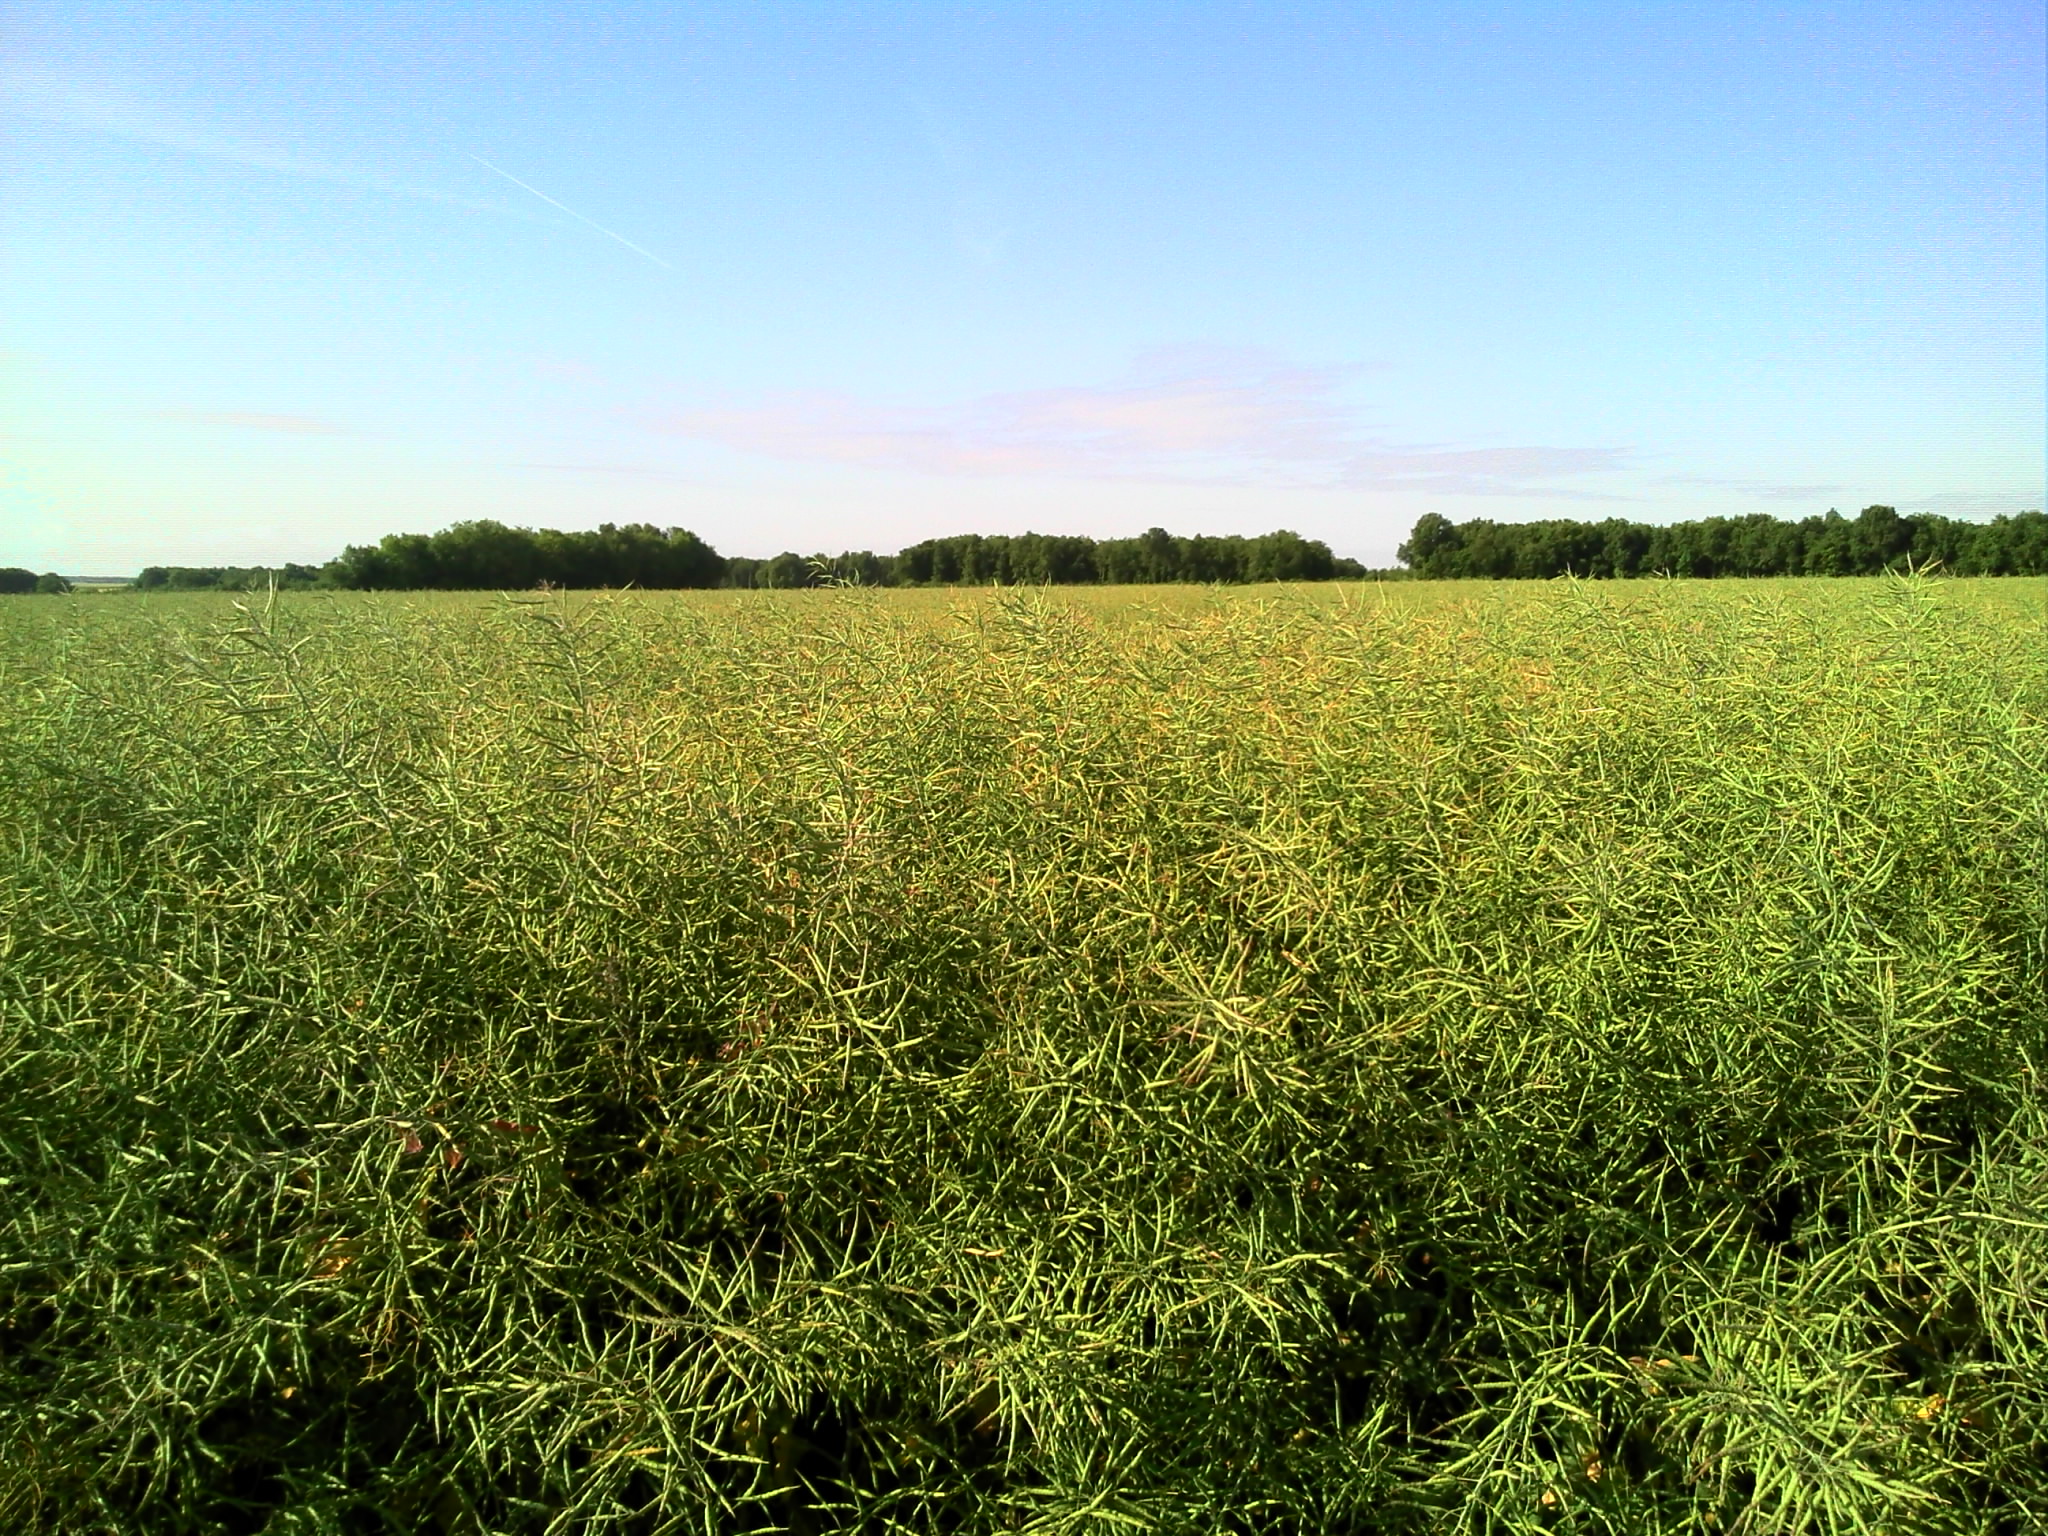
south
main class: Cropland
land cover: Rape and turnip rape
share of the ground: > 75 %
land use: Agriculture (excluding fallow land and kitchen gardens)
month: May
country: FR
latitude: 47.0580
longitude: 0.1692
